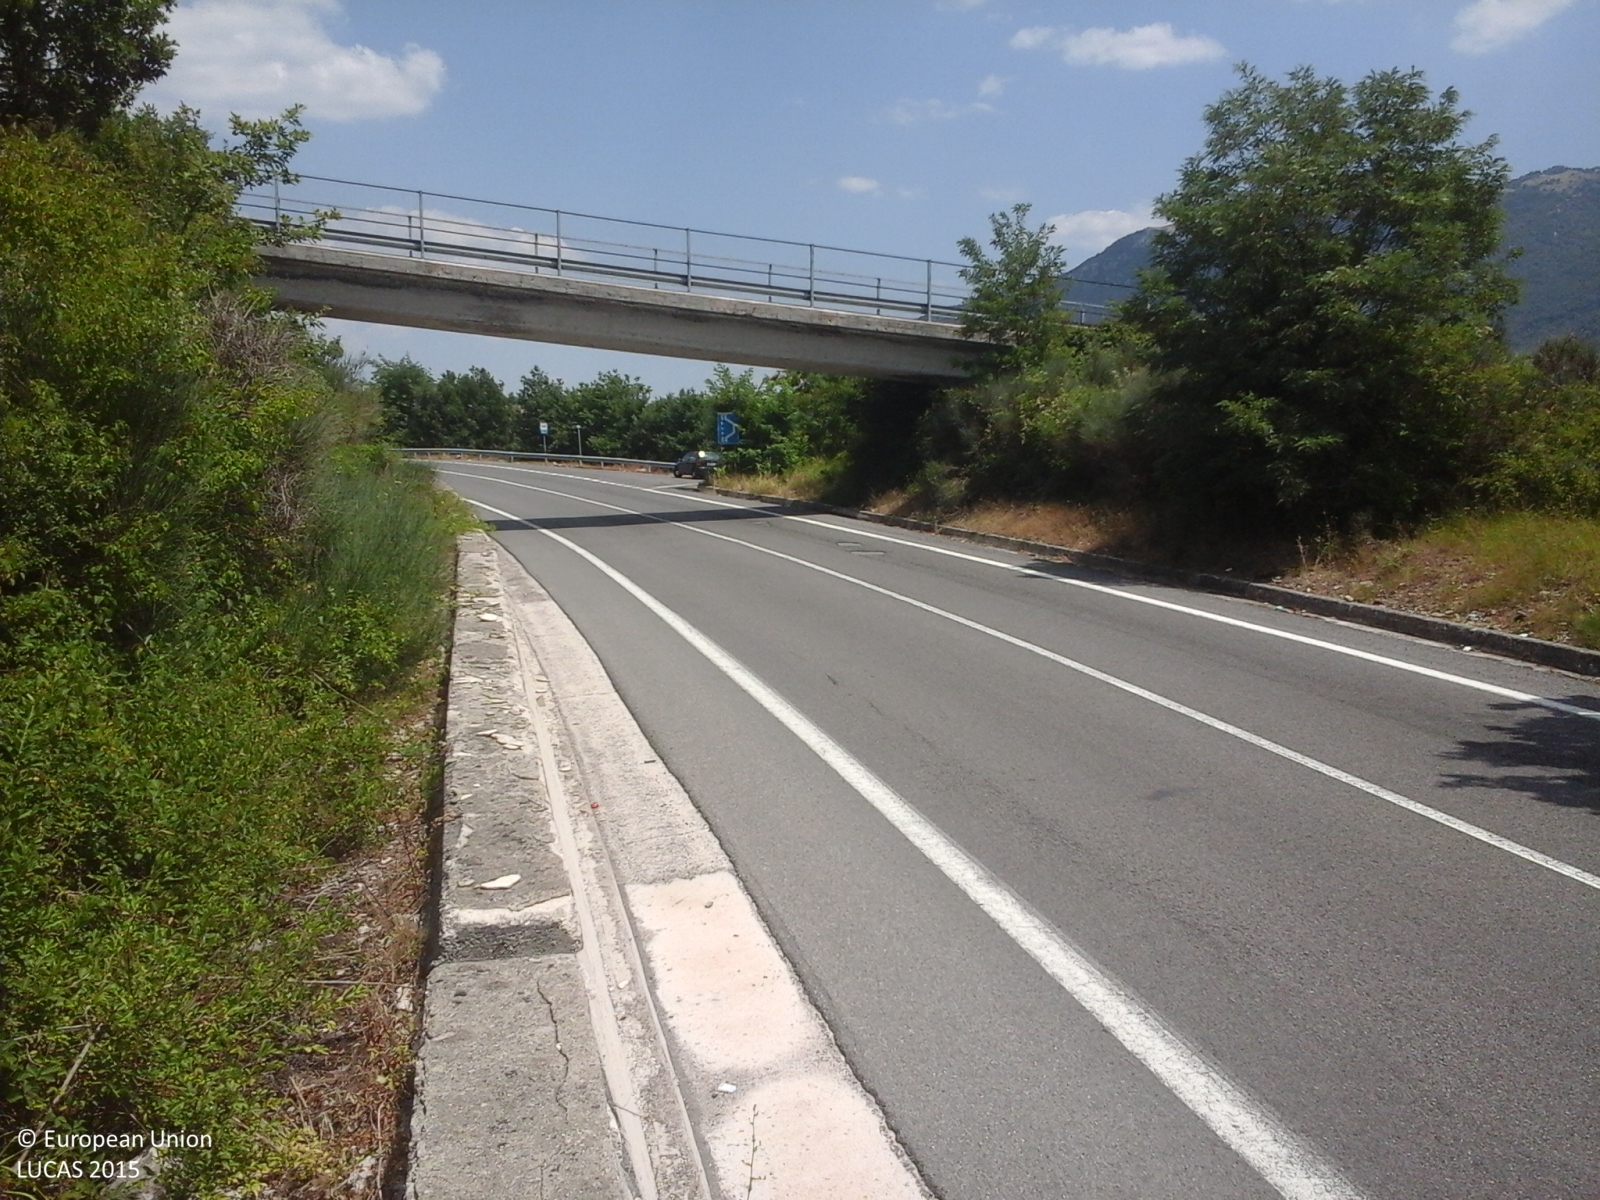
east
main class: Woodland
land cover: Broadleaved woodland
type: thermophilous deciduous forest
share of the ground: > 75 %
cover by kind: broadleaved forest trees 80 %, shrubs 15 %, herbaceous plants 5 %
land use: Forestry
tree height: > 5 m
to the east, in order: Broadleaved woodland; Tracks; Broadleaved woodland; Tracks; Shrubland with sparse tree cover; Paved roads, cycling and walking lanes; Broadleaved woodland; Shrubland without tree cover; Tracks; Shruby margins; Lucerne; Shrubland without tree cover; Broadleaved woodland
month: July
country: IT
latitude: 40.8613
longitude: 15.0696
